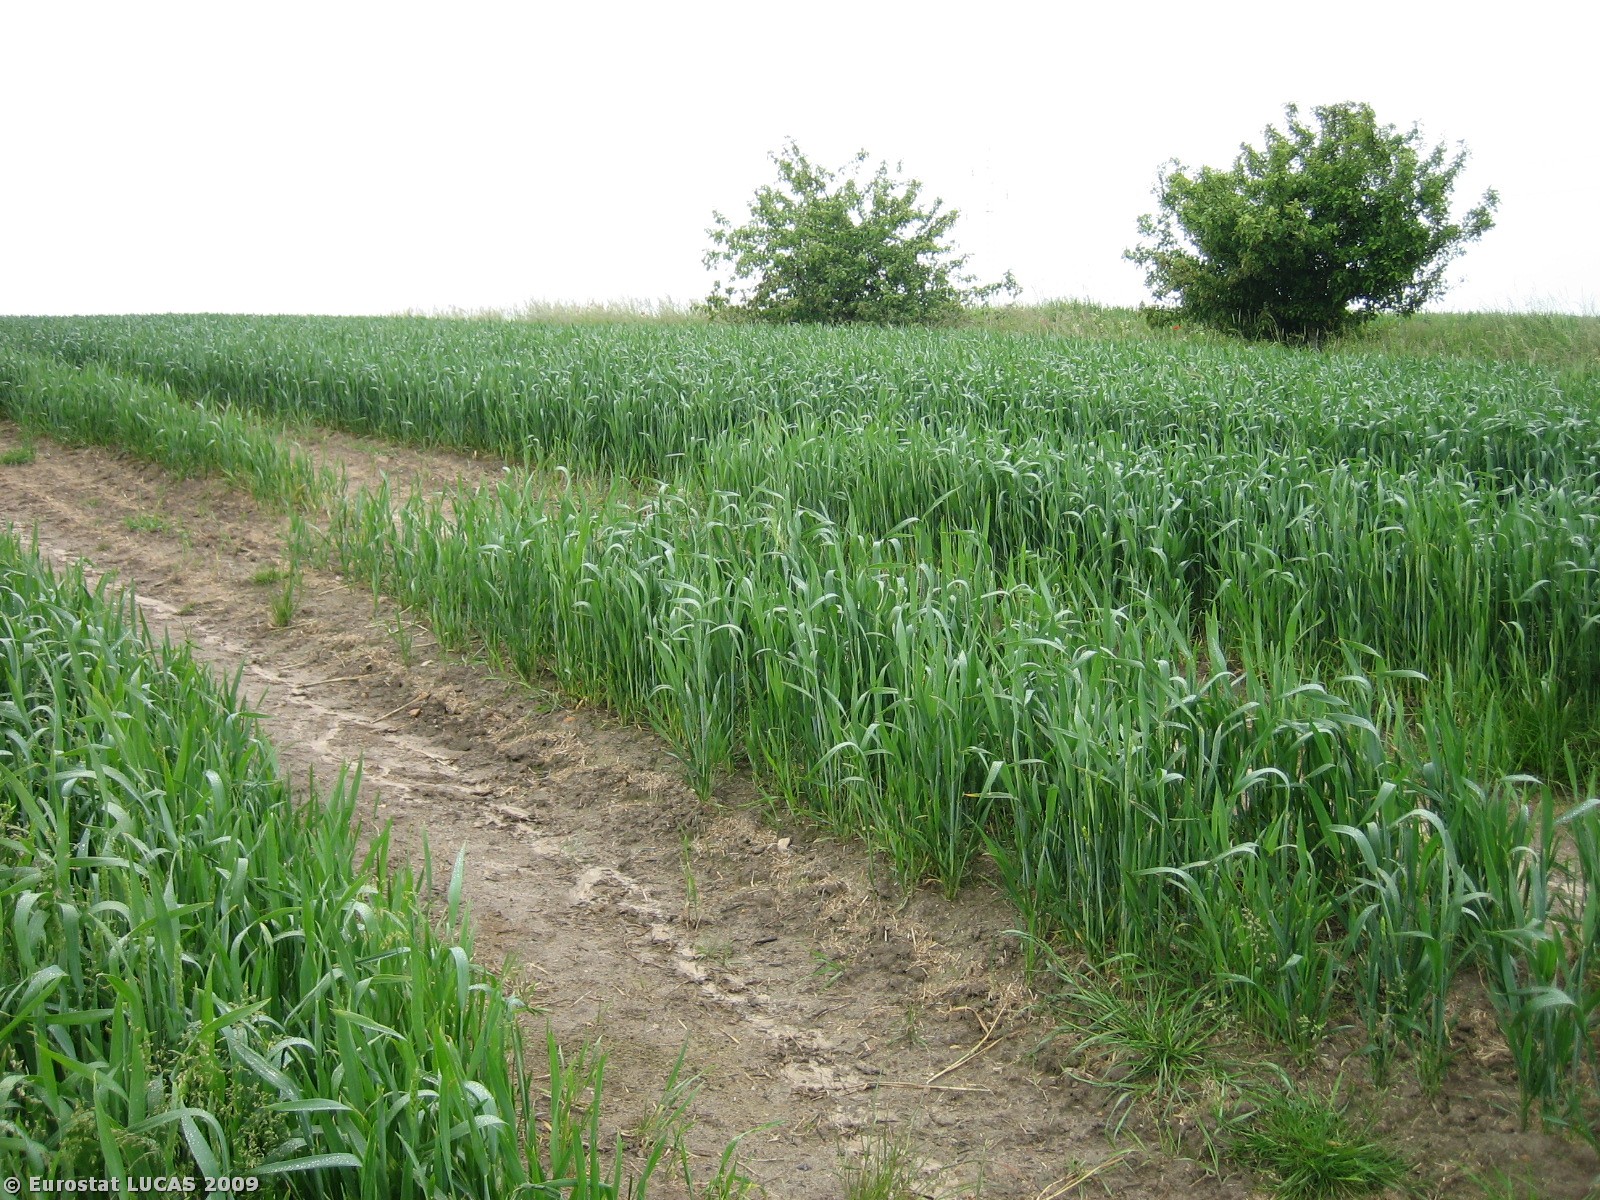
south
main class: Cropland
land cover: Common wheat
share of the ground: > 75 %
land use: Agriculture (excluding fallow land and kitchen gardens)
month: June
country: DK
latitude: 56.0078
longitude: 10.2083
